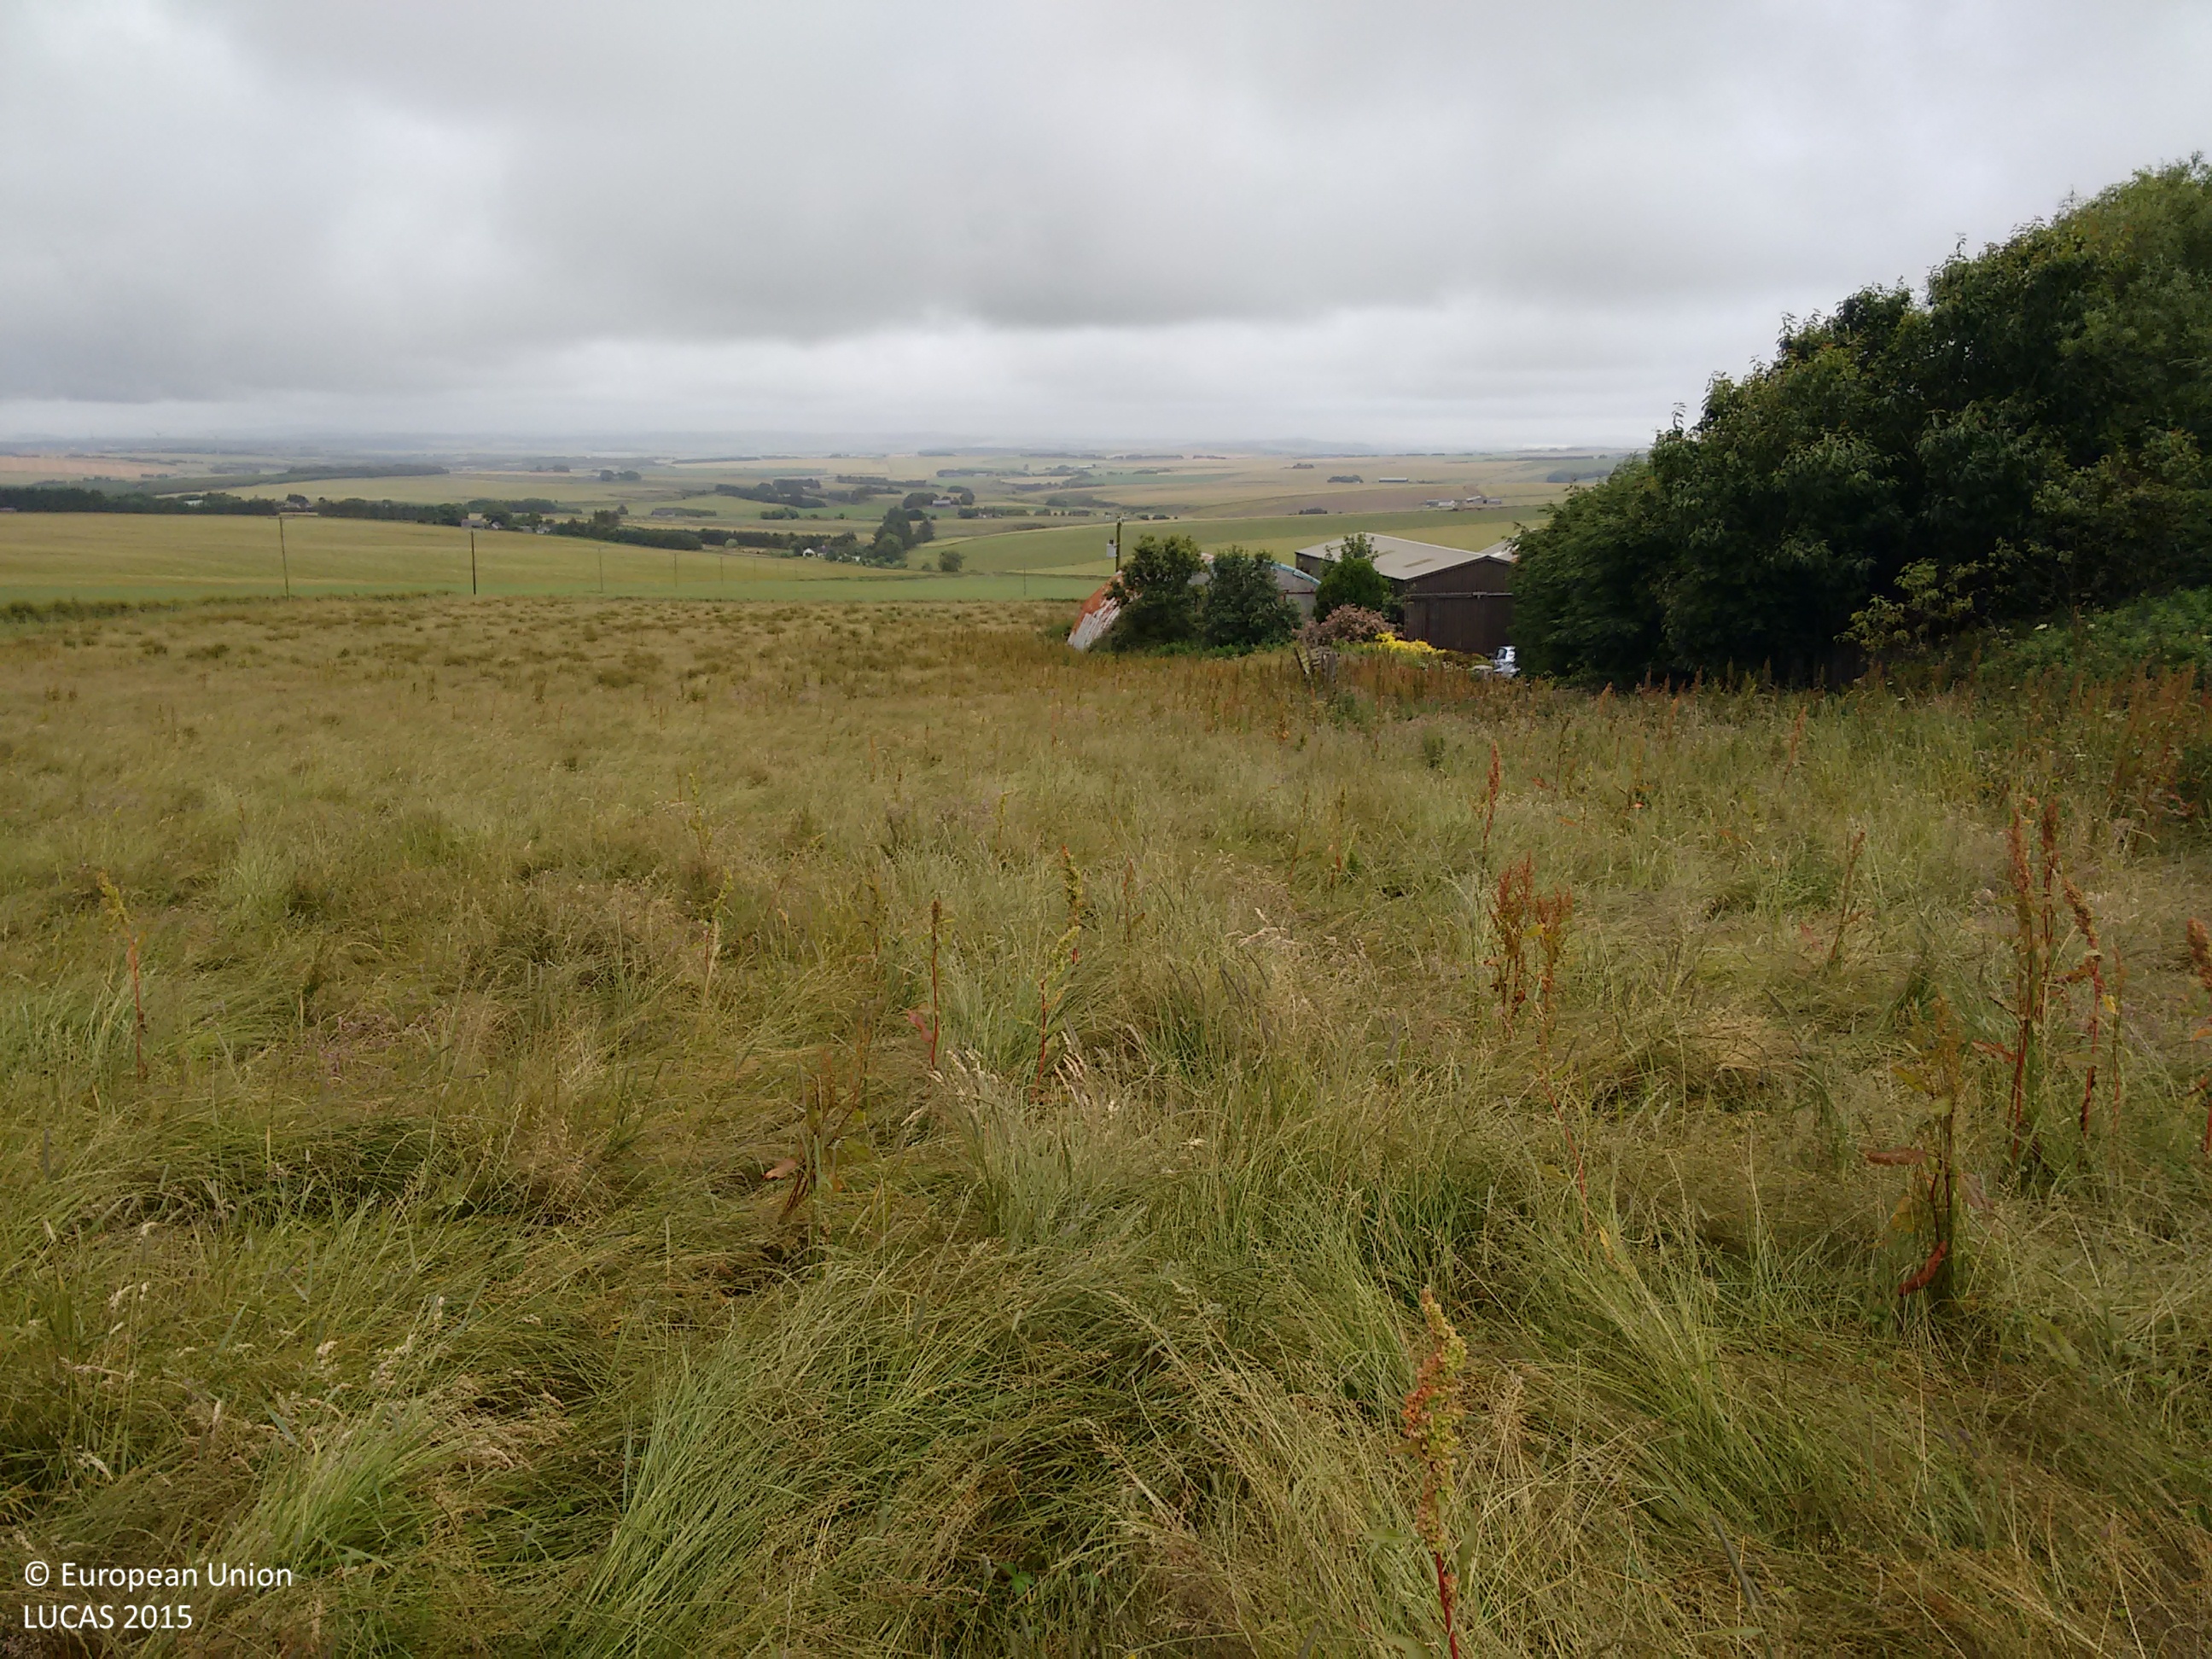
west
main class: Grassland
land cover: Grassland without tree/shrub cover
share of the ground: > 75 %
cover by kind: herbaceous plants 100 %
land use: Agriculture (excluding fallow land and kitchen gardens)
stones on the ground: 25 - 50 %
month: July
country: GB
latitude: 57.6313
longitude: -2.3252
